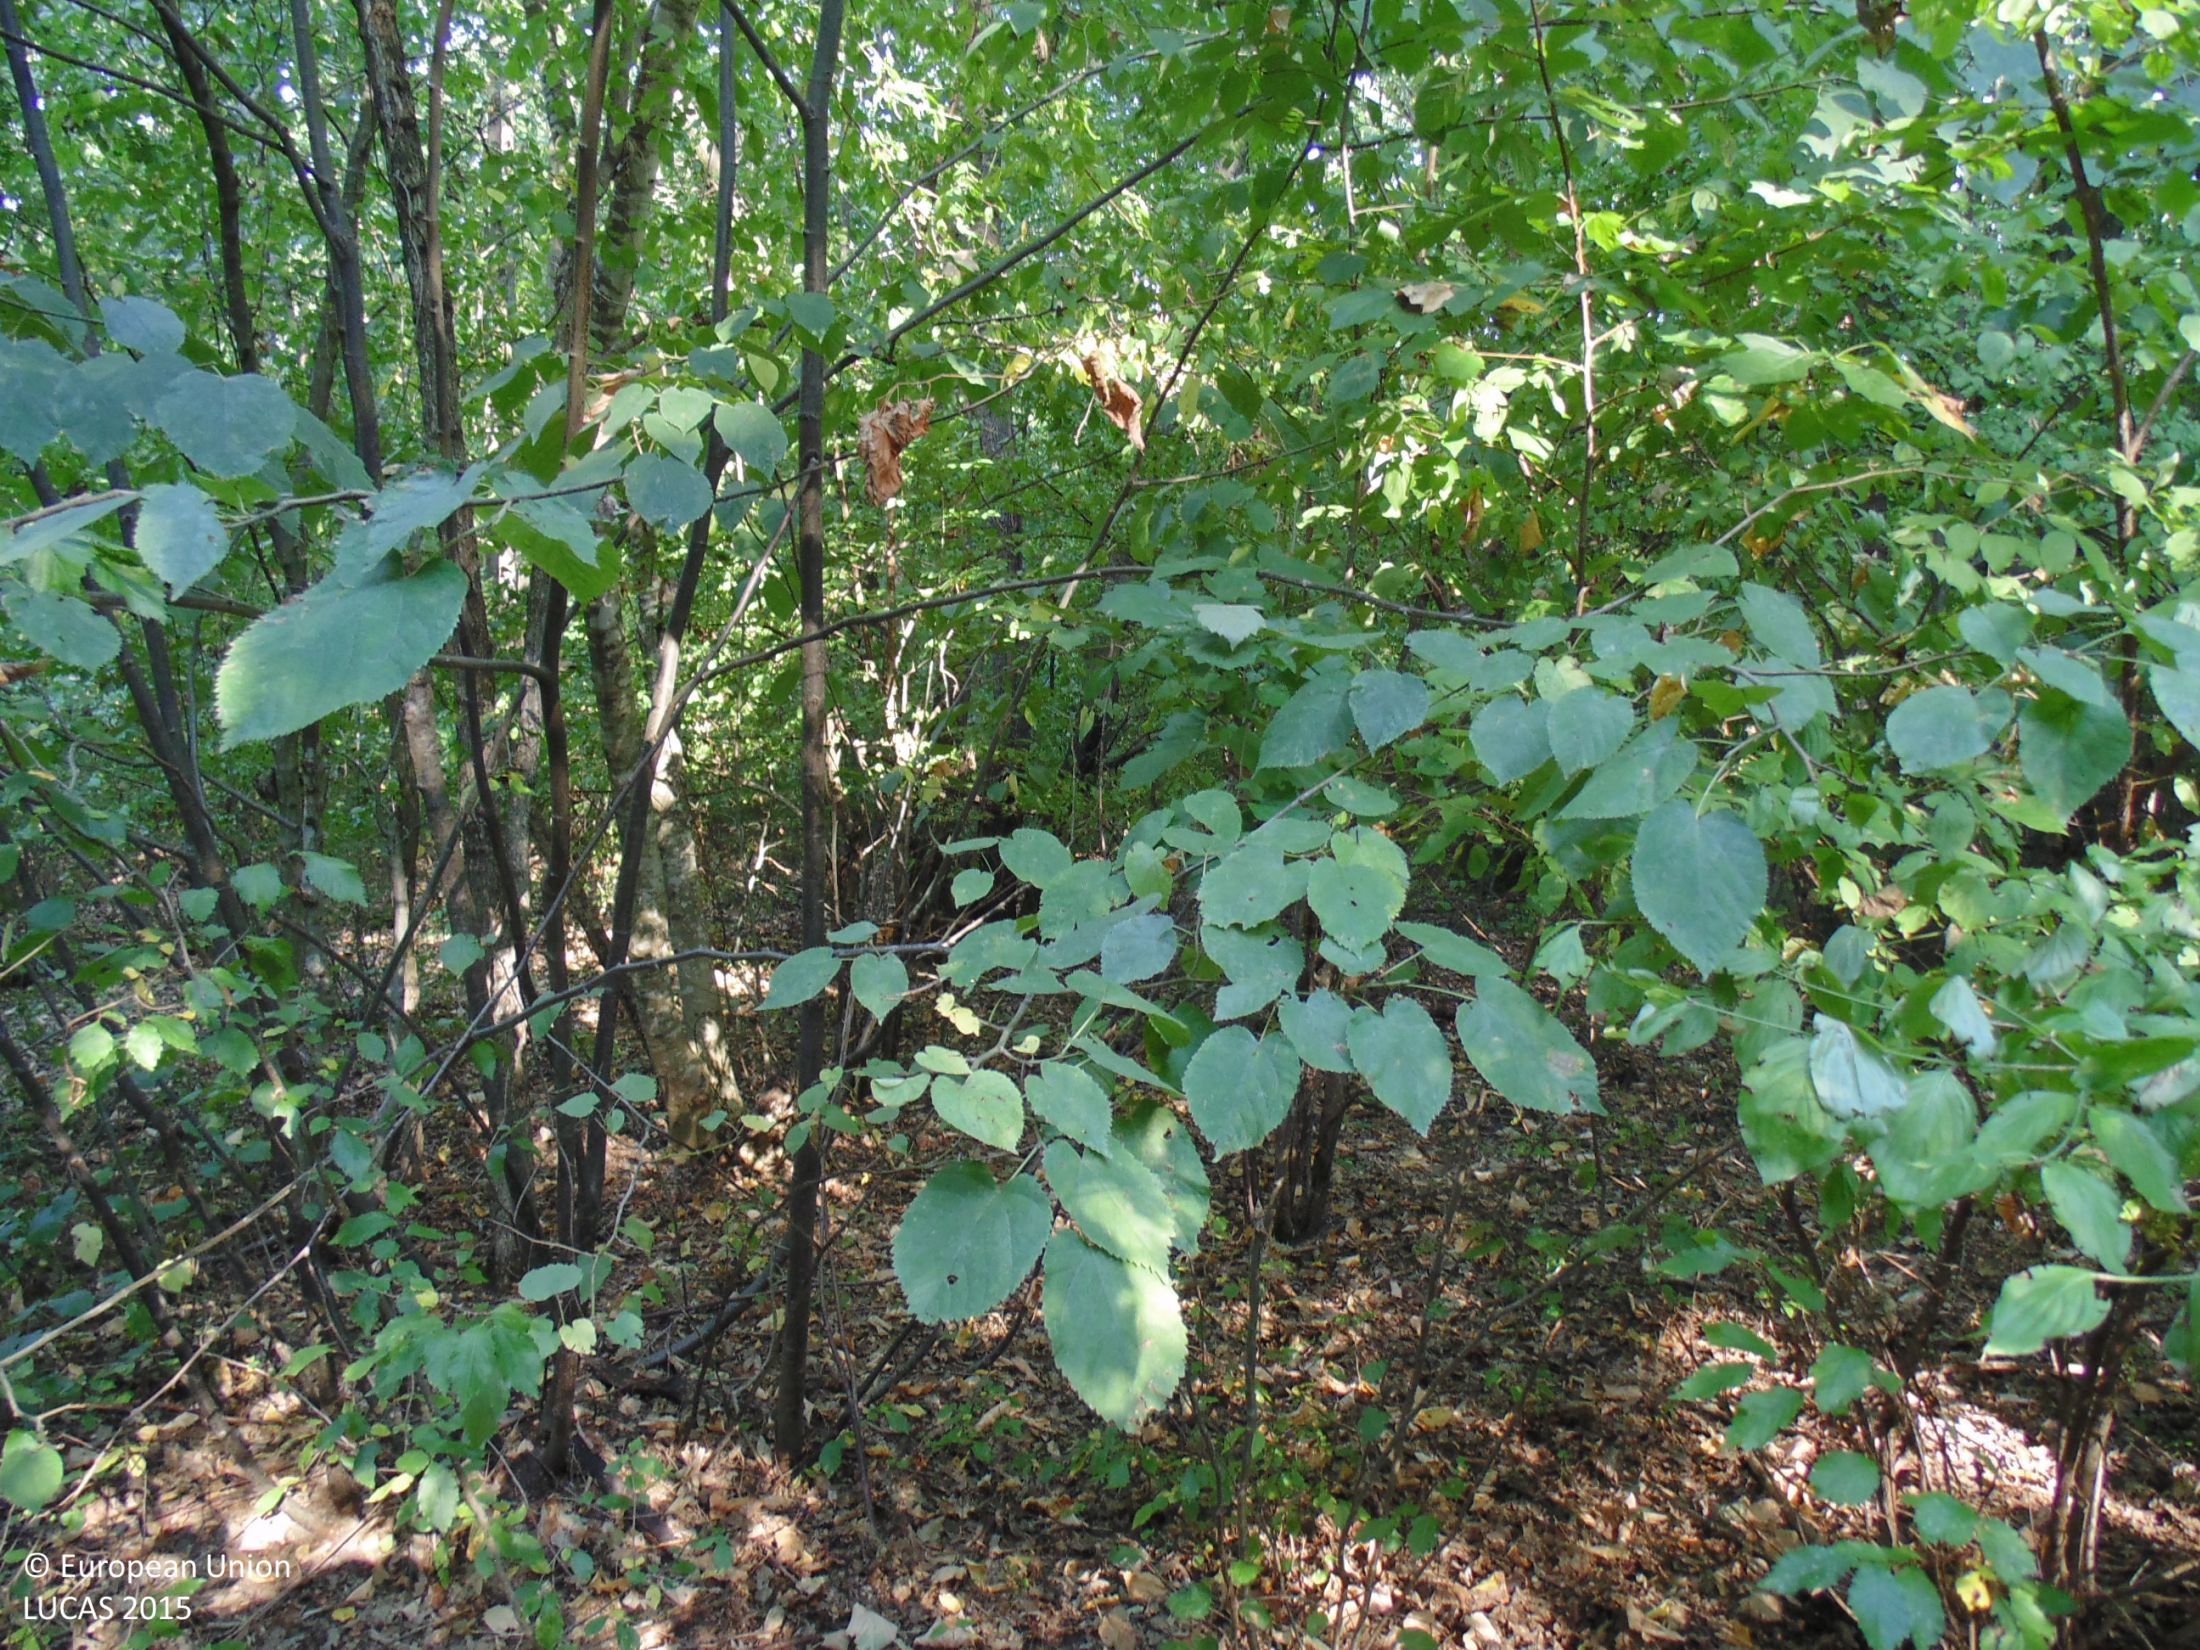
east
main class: Woodland
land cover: Broadleaved woodland
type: mesophytic deciduous forest
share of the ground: > 75 %
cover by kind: broadleaved forest trees 90 %, shrubs 5 %, unconsolidated bare surface 5 %
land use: Forestry
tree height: > 5 m
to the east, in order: Broadleaved woodland
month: September
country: BG
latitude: 43.8534
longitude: 26.9009
